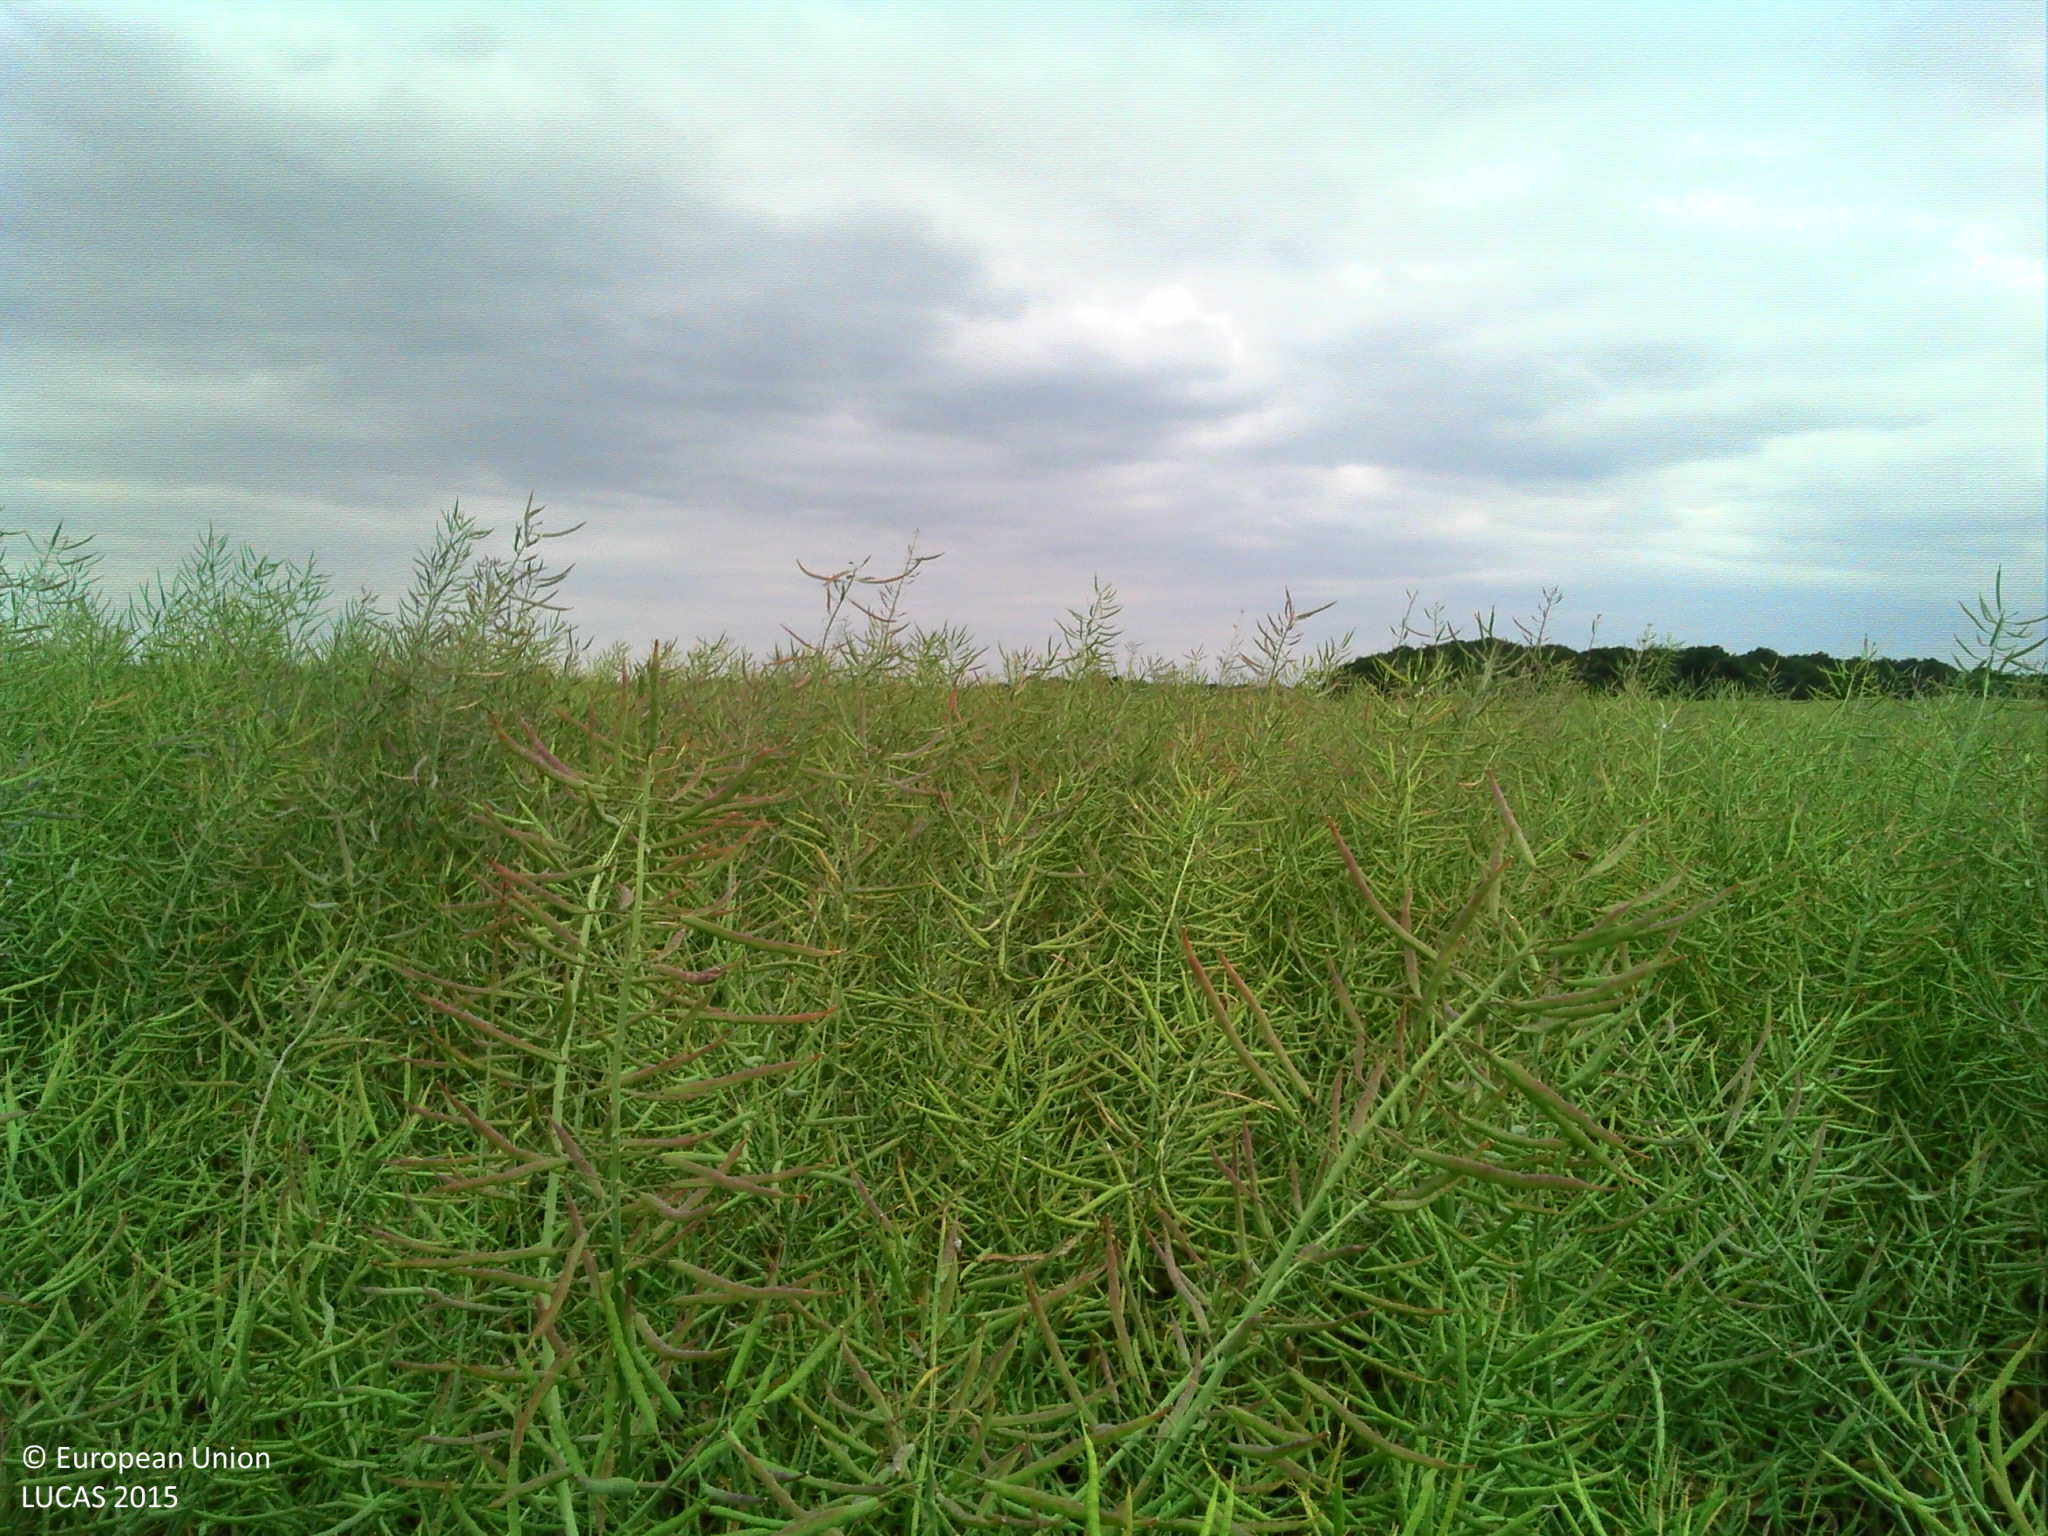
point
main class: Cropland
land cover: Rape and turnip rape
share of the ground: > 75 %
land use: Agriculture (excluding fallow land and kitchen gardens)
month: June
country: FR
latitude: 47.3448
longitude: 5.2224
